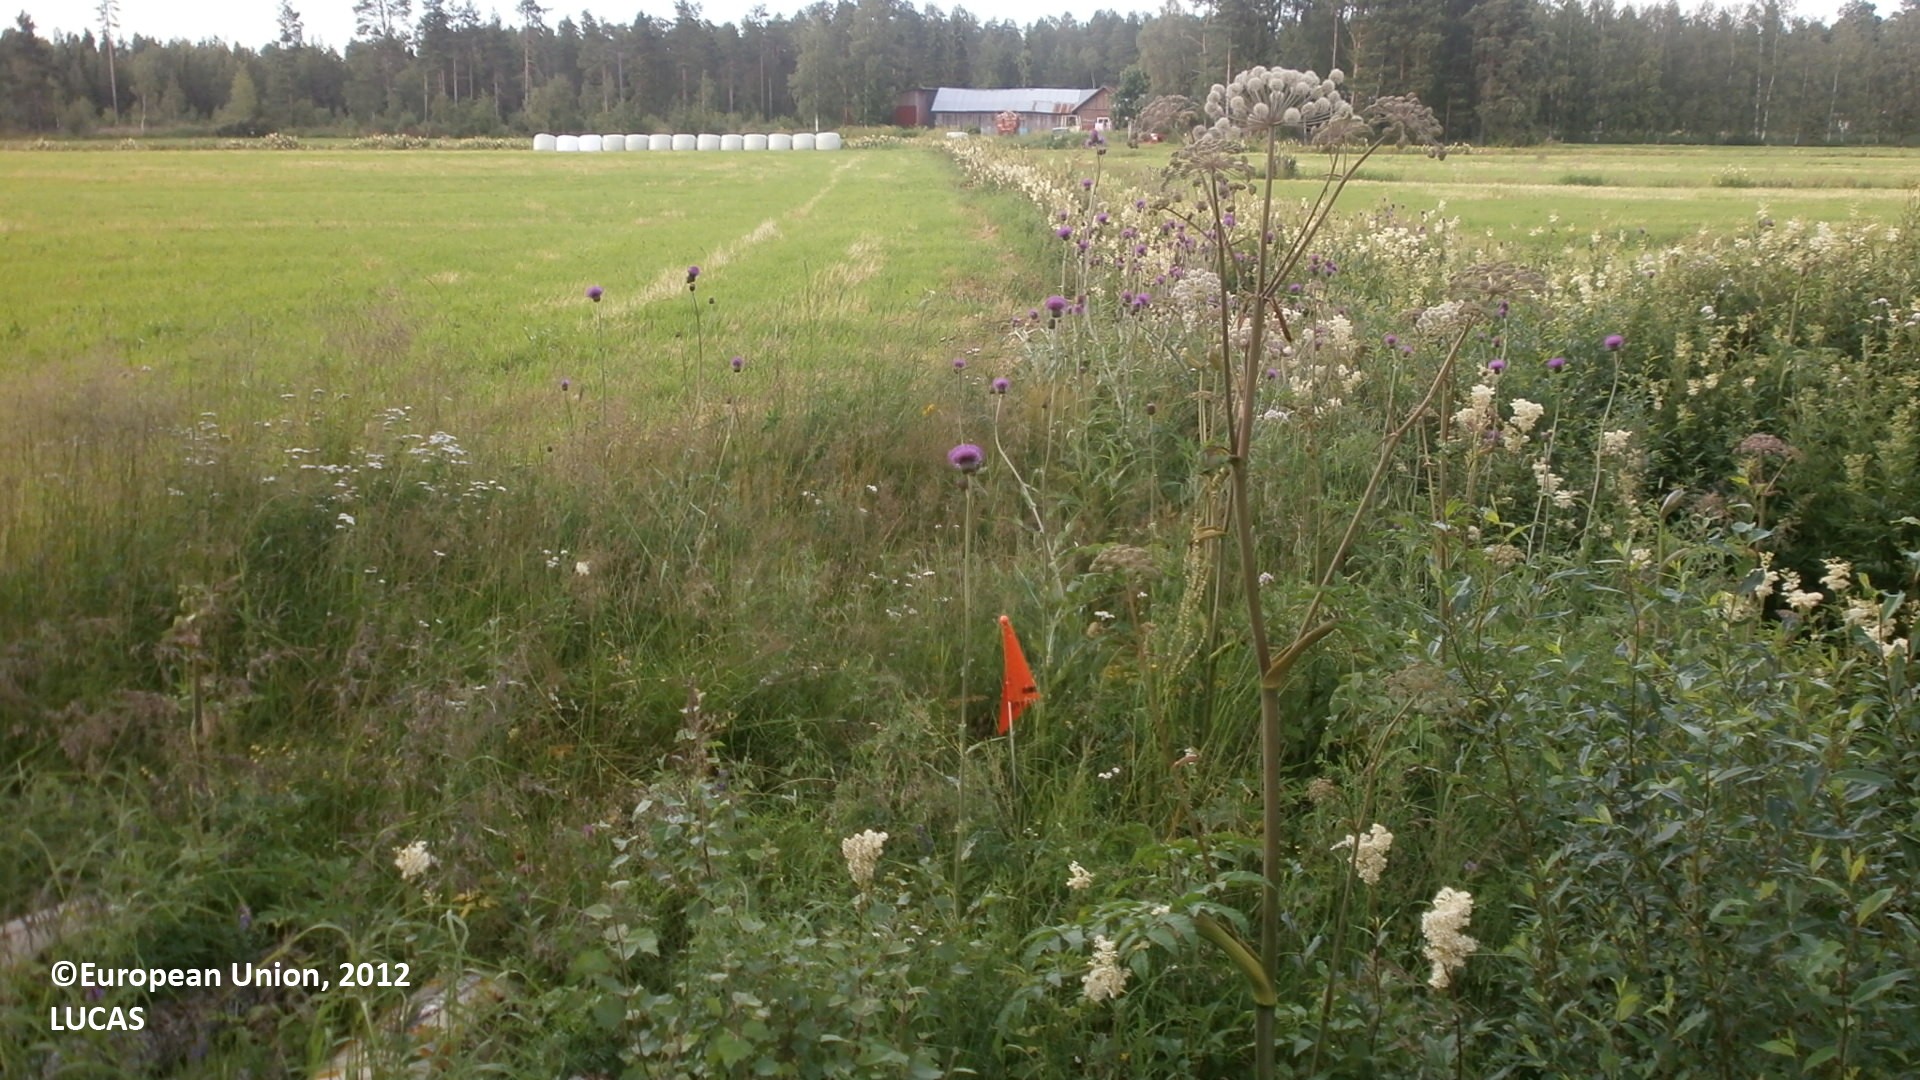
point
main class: Grassland
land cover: Grassland without tree/shrub cover
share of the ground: > 75 %
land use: Agriculture (excluding fallow land and kitchen gardens)
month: July
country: FI
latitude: 64.4535
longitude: 24.2178
